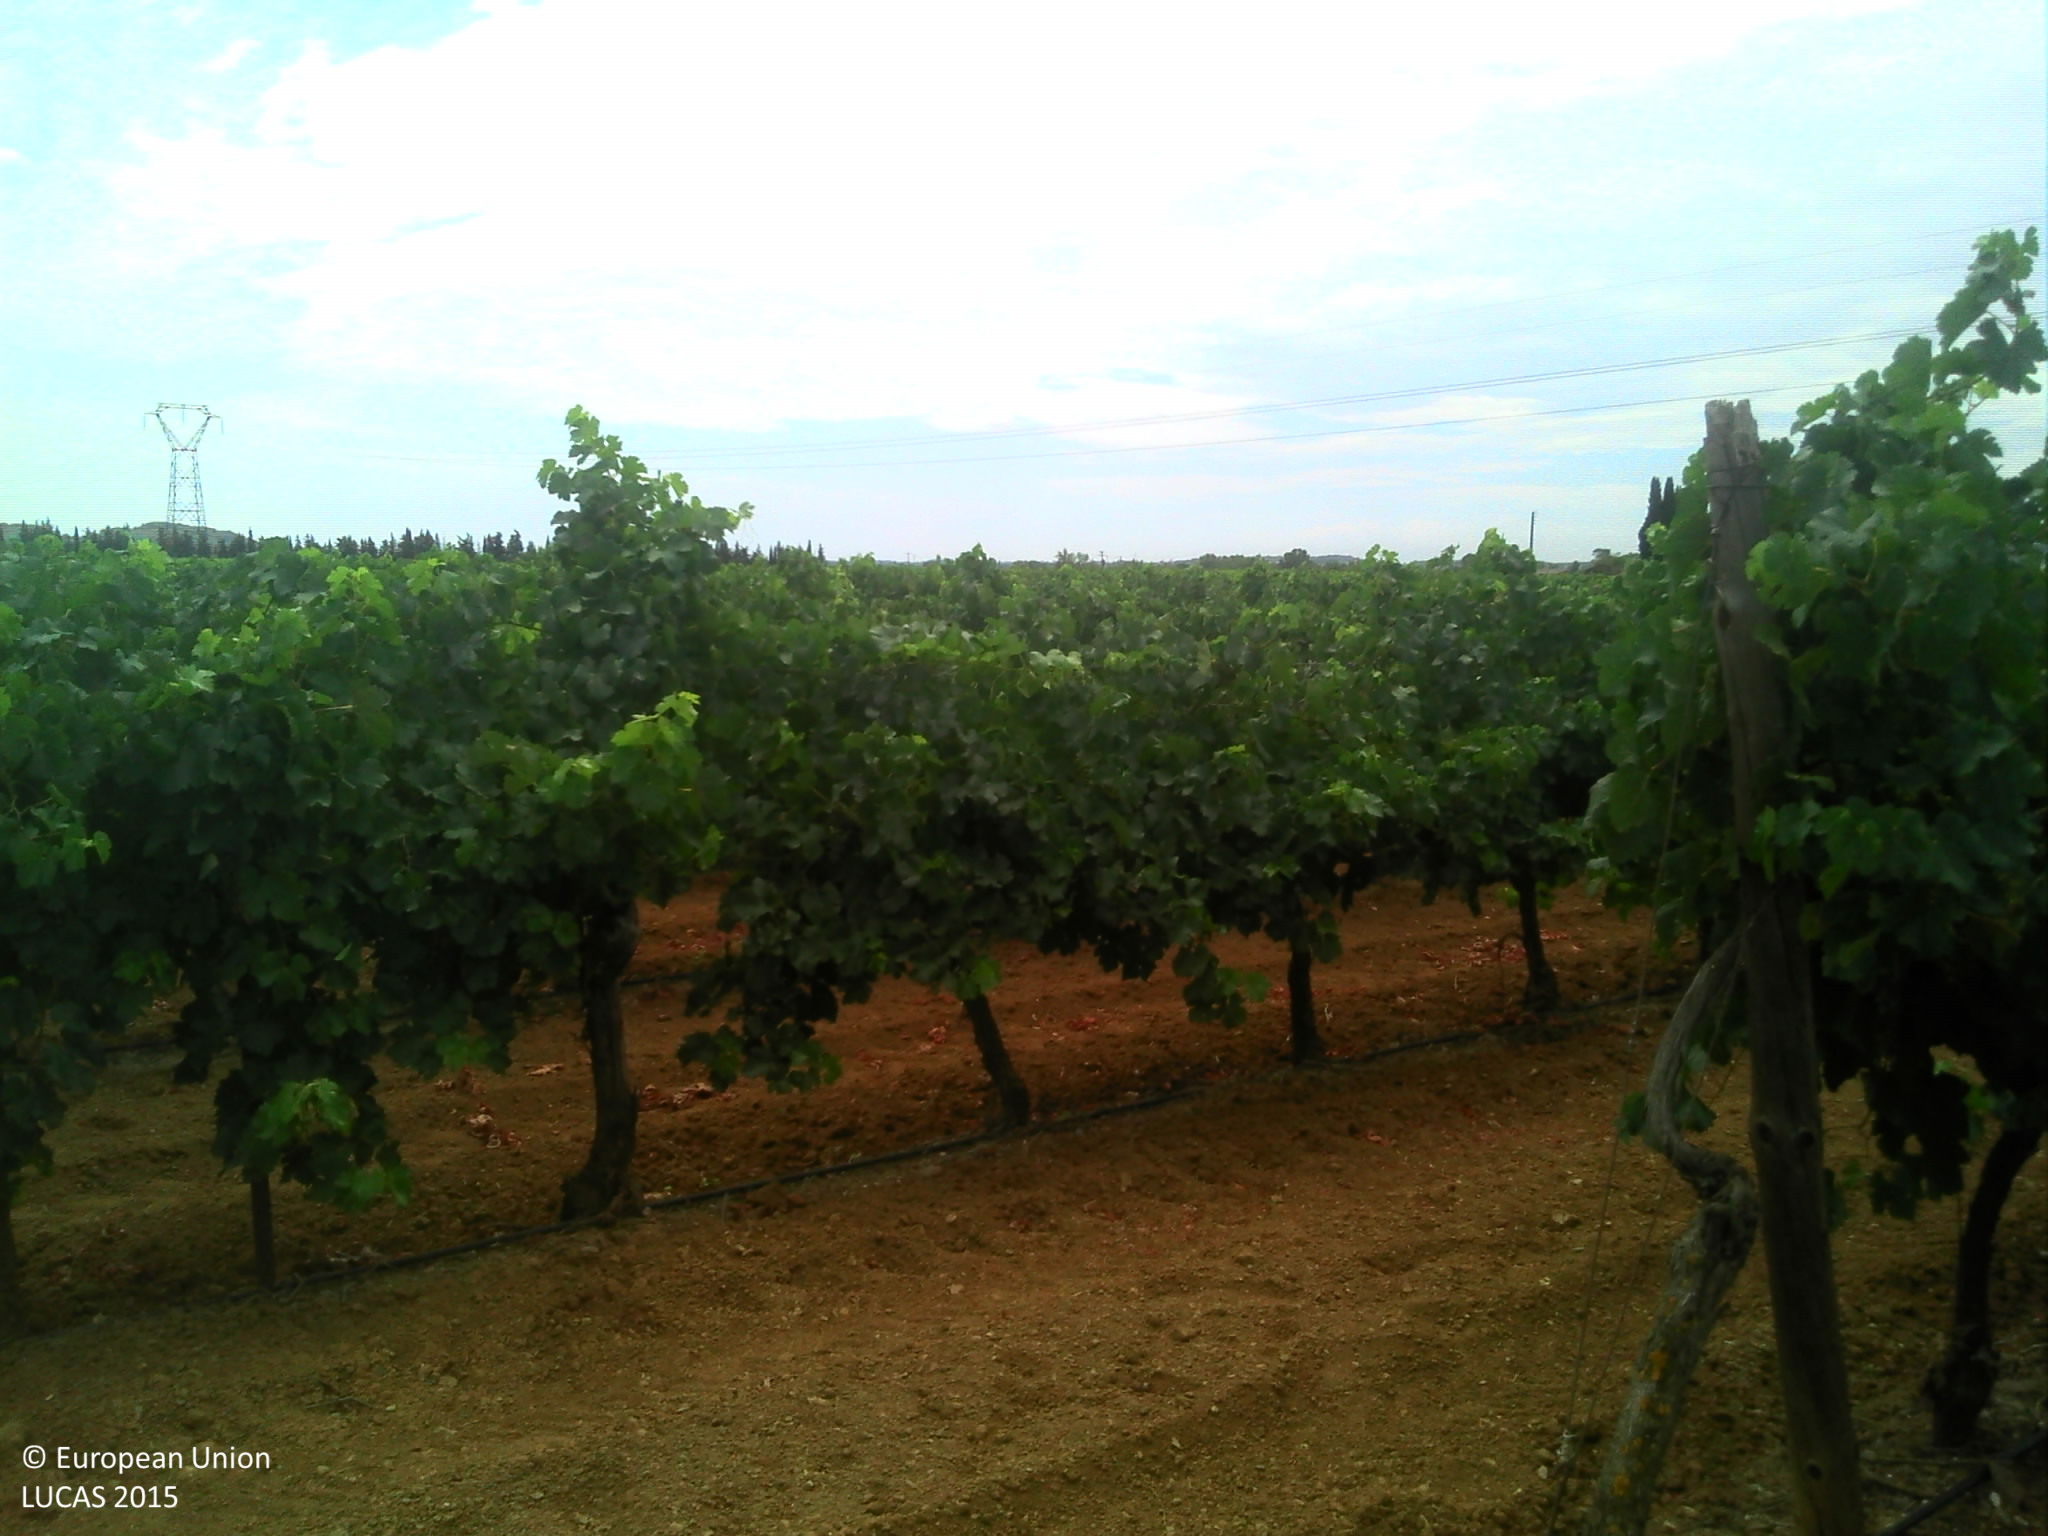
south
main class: Cropland
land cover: Vineyards
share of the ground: 25 - 50 %
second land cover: Other bare soil
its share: > 75 %
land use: Agriculture (excluding fallow land and kitchen gardens)
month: July
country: FR
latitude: 43.4184
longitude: 3.1542
